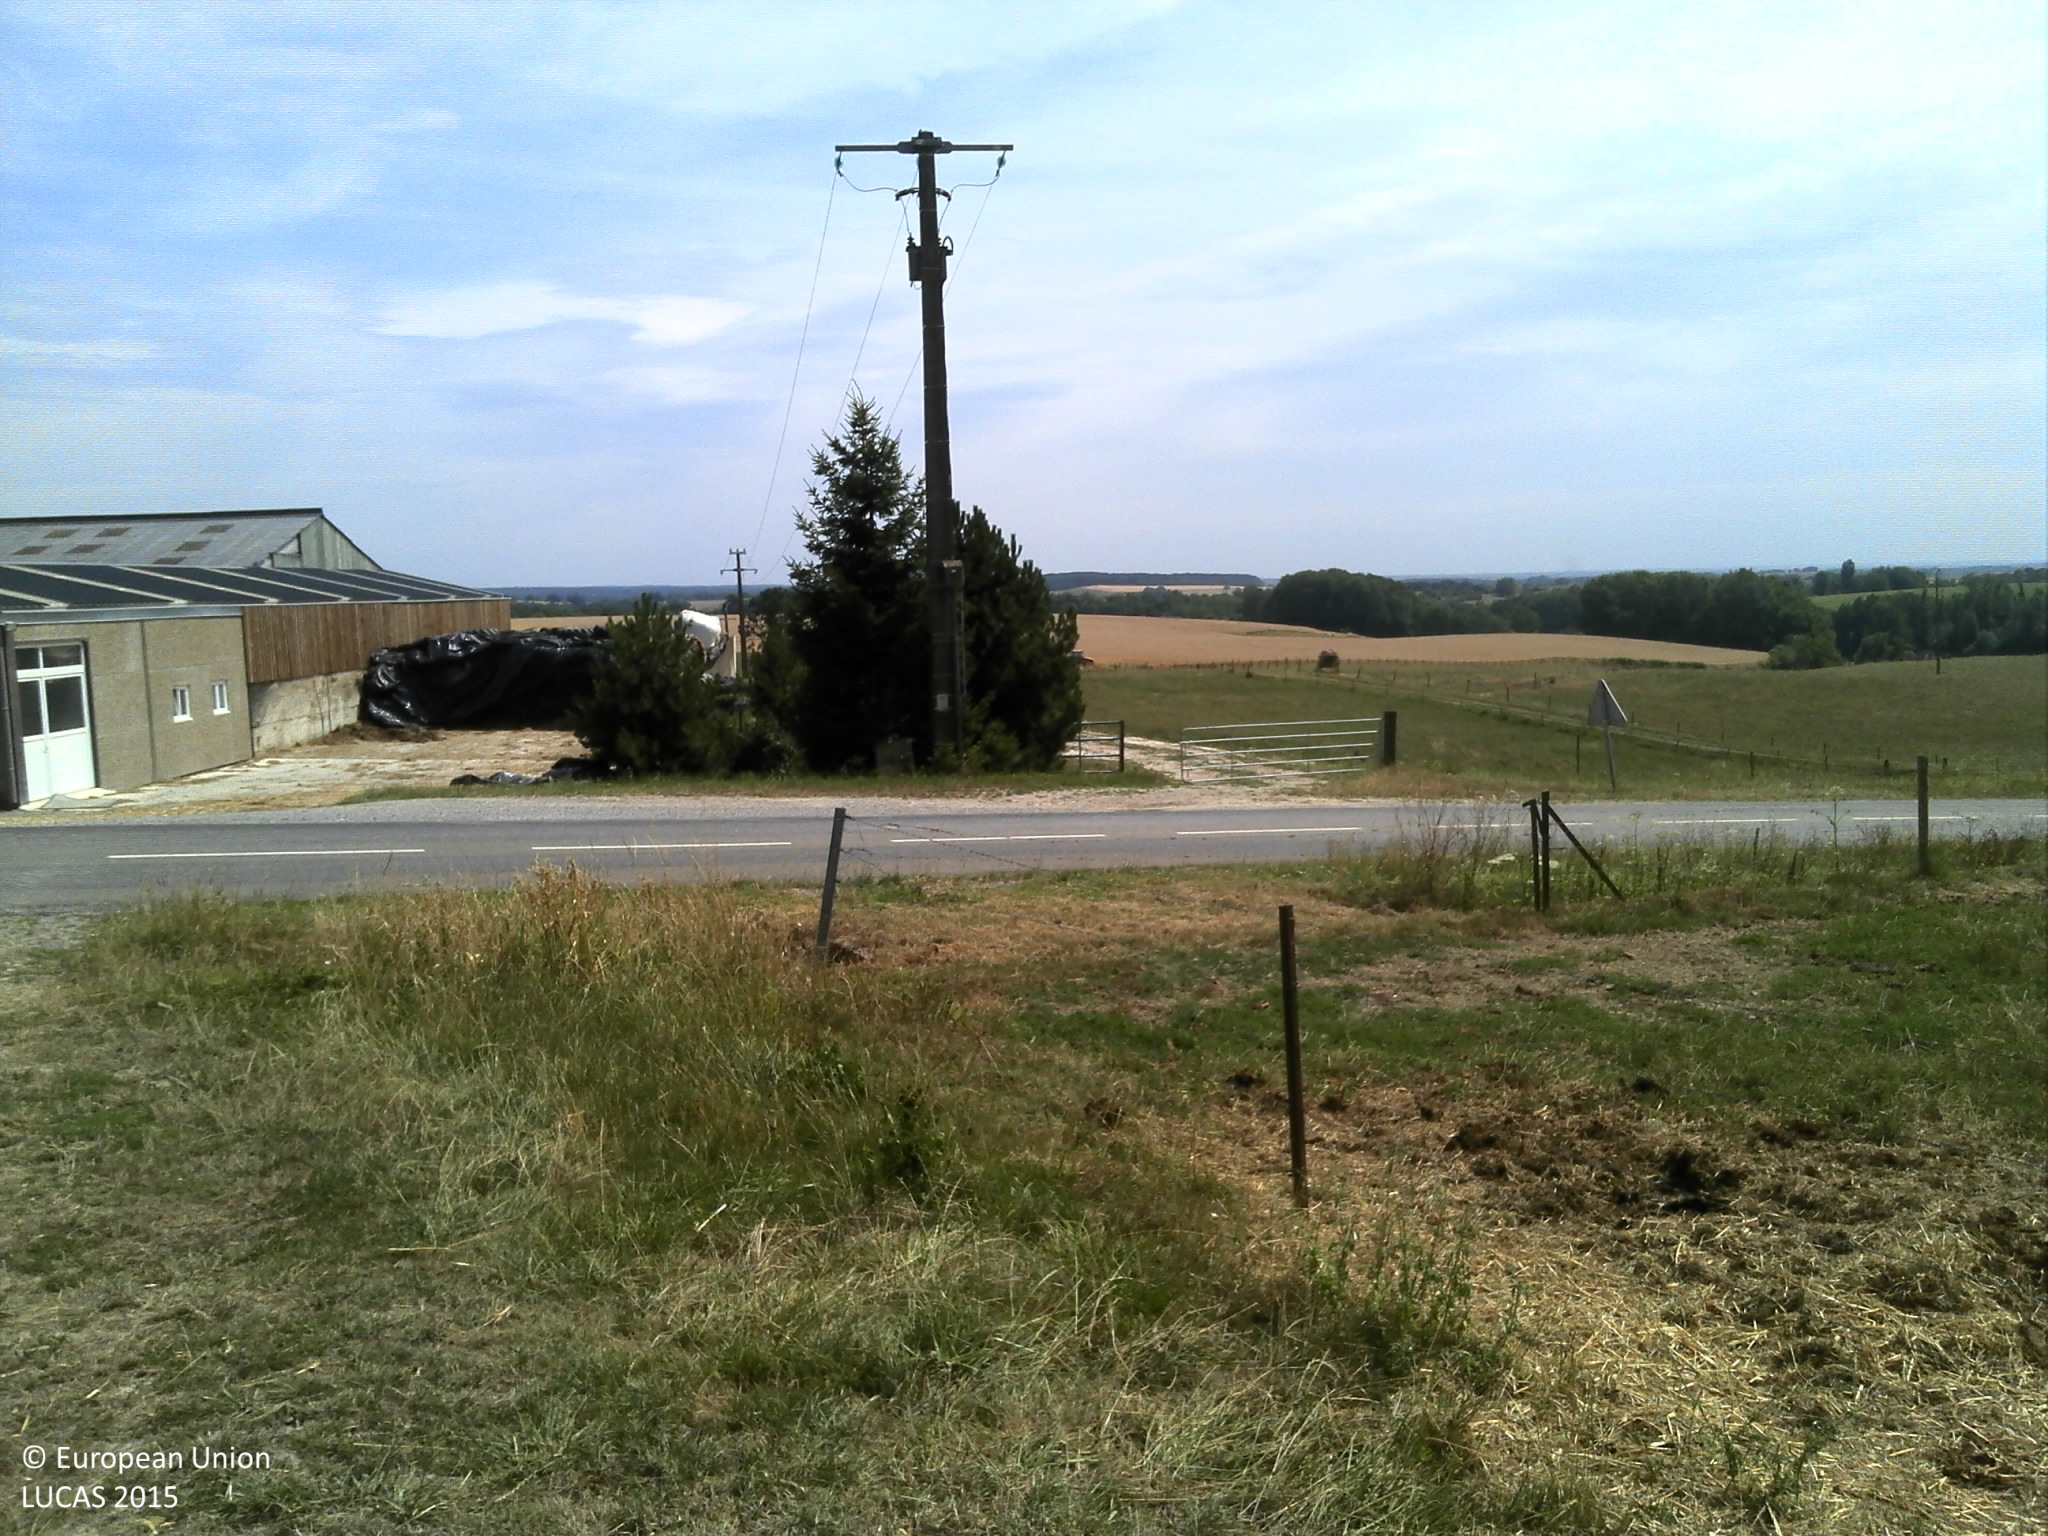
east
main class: Cropland
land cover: Clovers
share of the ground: > 75 %
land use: Agriculture (excluding fallow land and kitchen gardens)
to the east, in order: Clovers; Grass margins; Ditches and canals; Grass margins; Paved roads, cycling and walking lanes; Tracks; Grassland without tree/shrub cover; Artificial constructions in urban areas; Grassland without tree/shrub cover; Electric lines; Grassland without tree/shrub cover
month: July
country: FR
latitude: 49.6604
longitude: 4.2462
